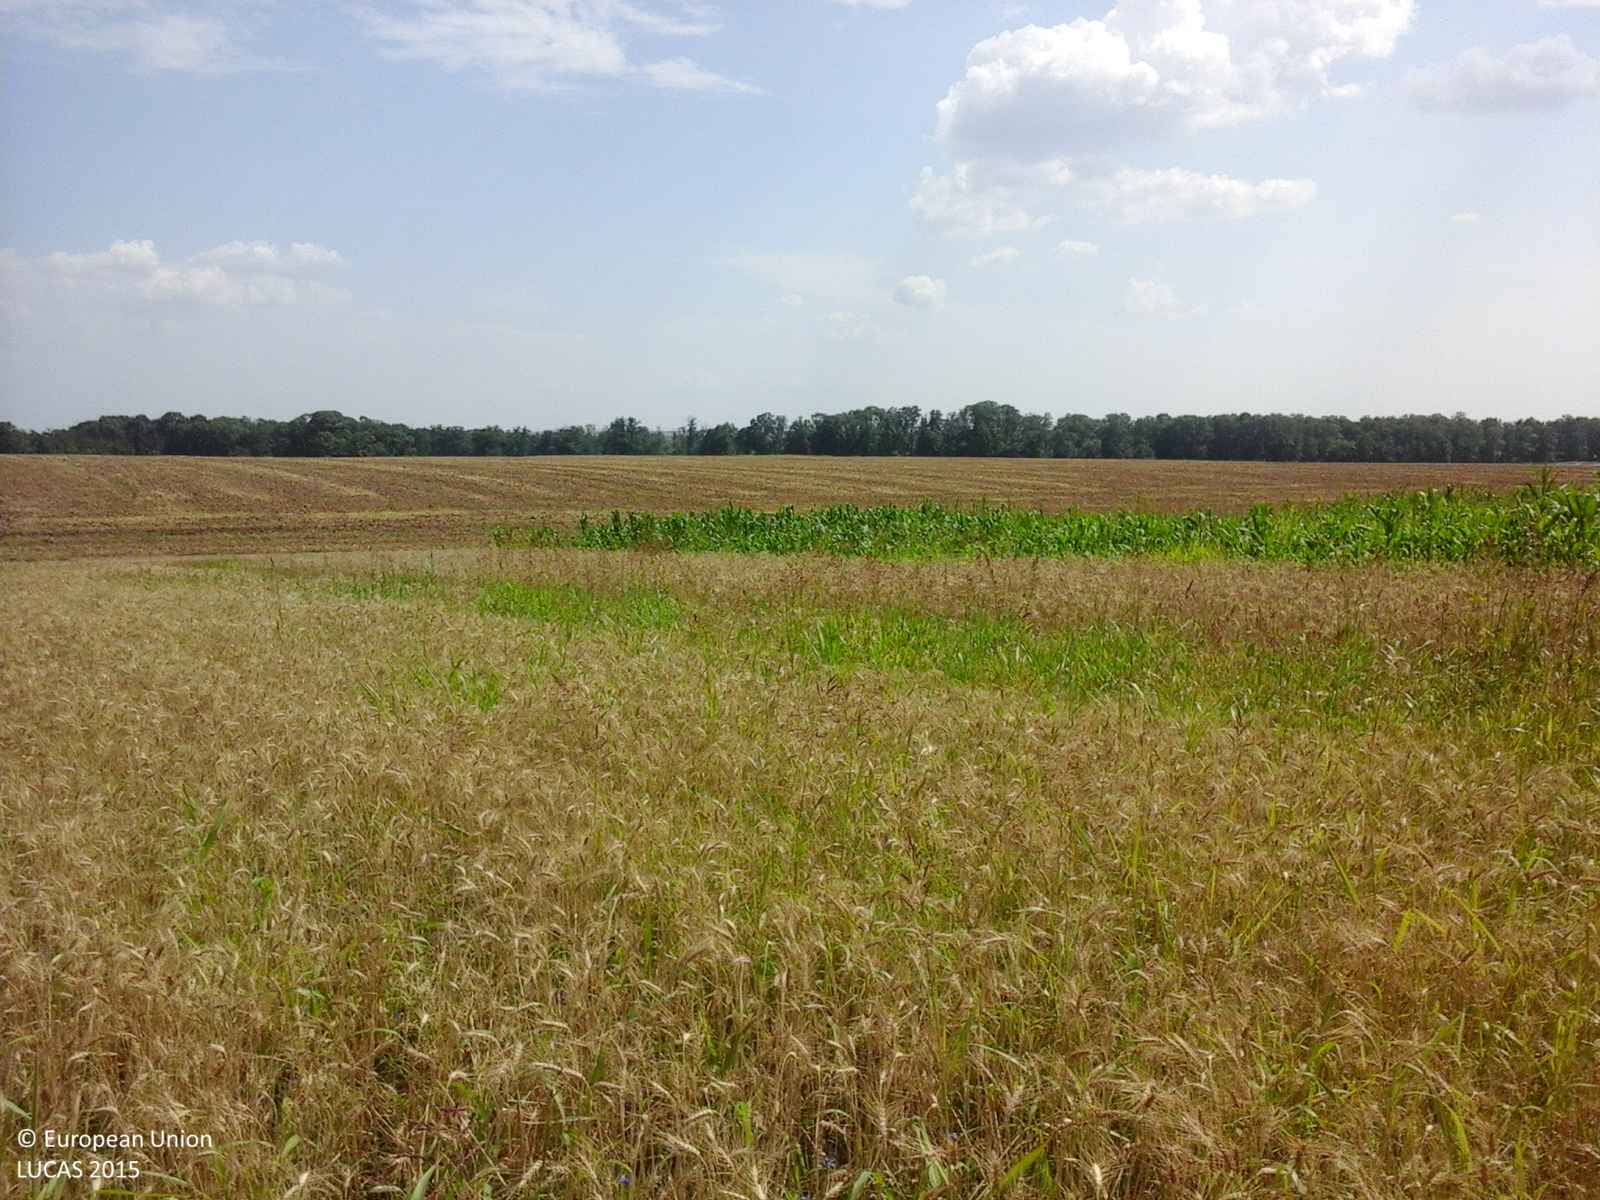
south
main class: Cropland
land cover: Common wheat
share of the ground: > 75 %
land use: Agriculture (excluding fallow land and kitchen gardens)
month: July
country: RO
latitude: 44.0199
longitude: 25.2641
